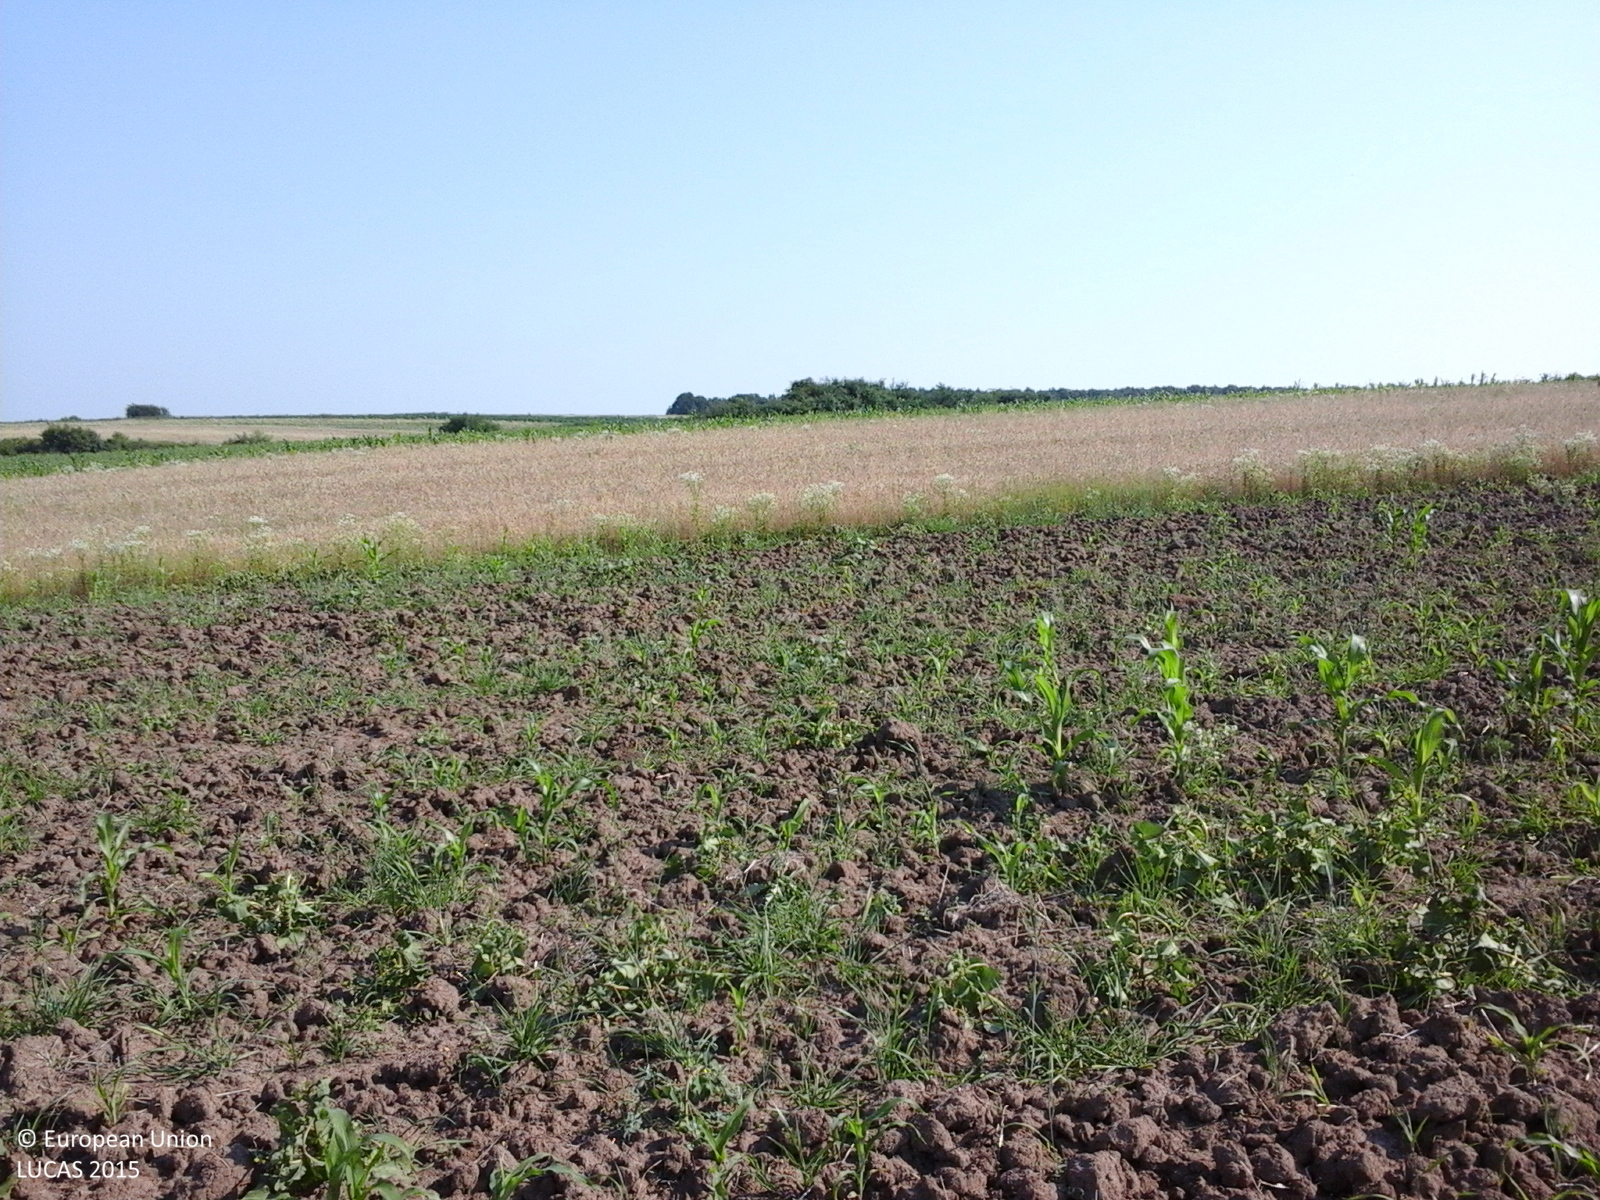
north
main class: Cropland
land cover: Maize
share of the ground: < 10 %
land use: Agriculture (excluding fallow land and kitchen gardens)
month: July
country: RO
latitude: 44.6105
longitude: 24.6028
